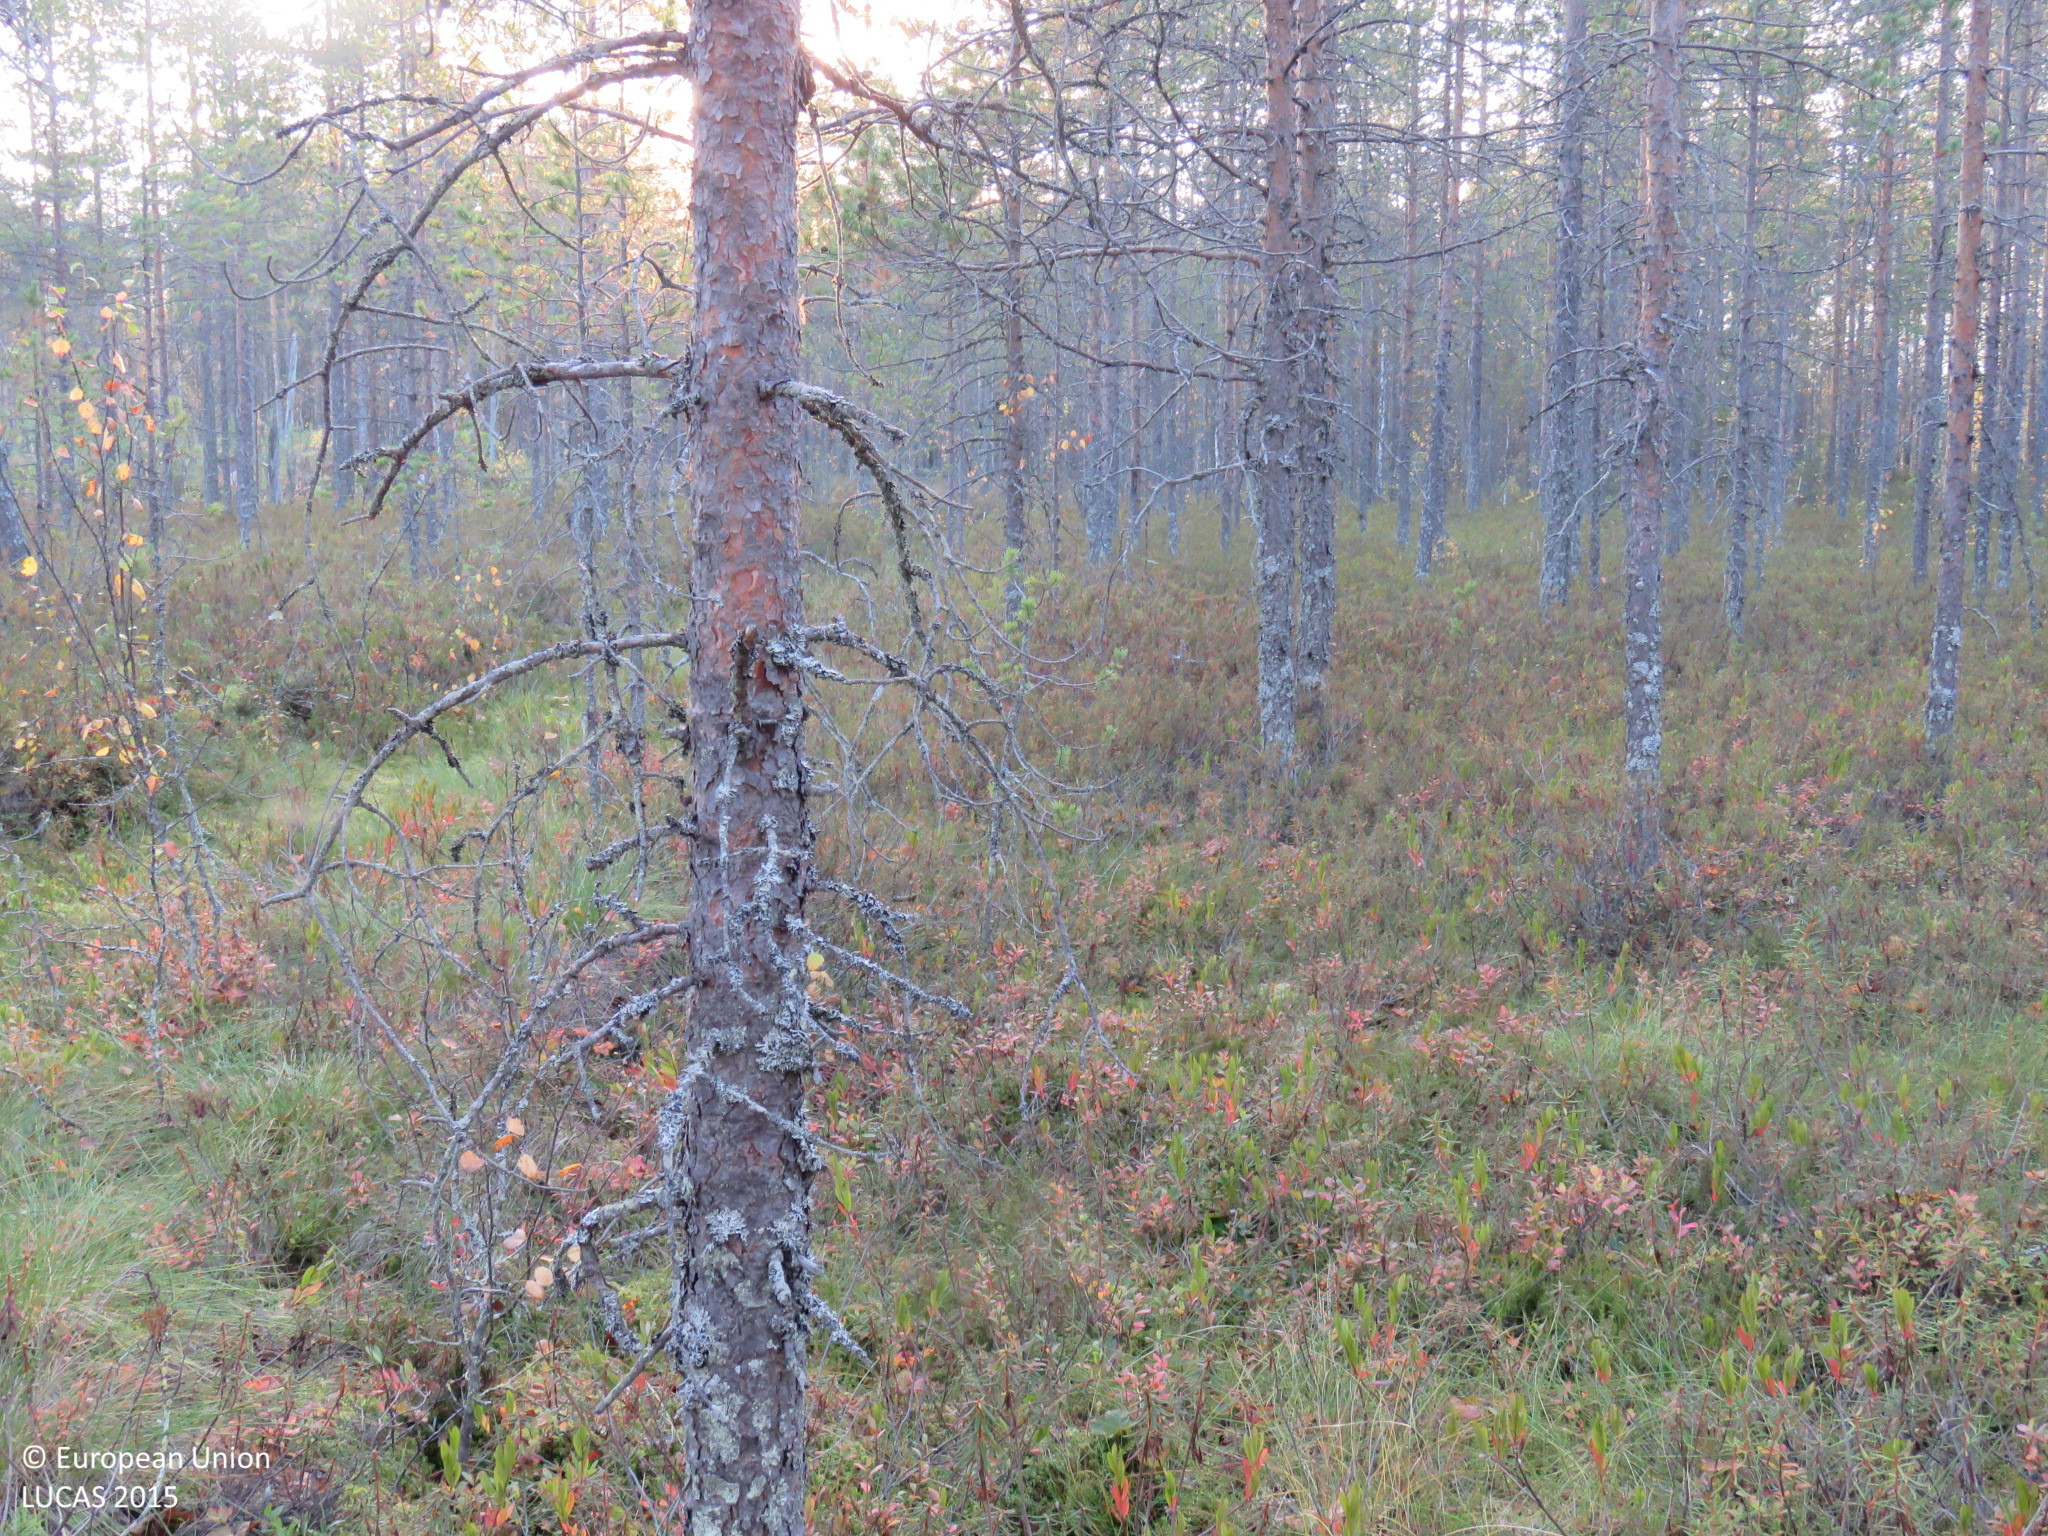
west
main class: Woodland
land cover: Pine dominated coniferous woodland
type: mire and swamp forests
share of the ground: > 75 %
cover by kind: coniferous forest trees 70 %, shrubs 15 %, broadleaved forest trees 5 %, herbaceous plants 5 %, lichens and mosses 5 %
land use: Forestry
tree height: > 5 m
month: September
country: FI
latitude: 65.0354
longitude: 26.7845
